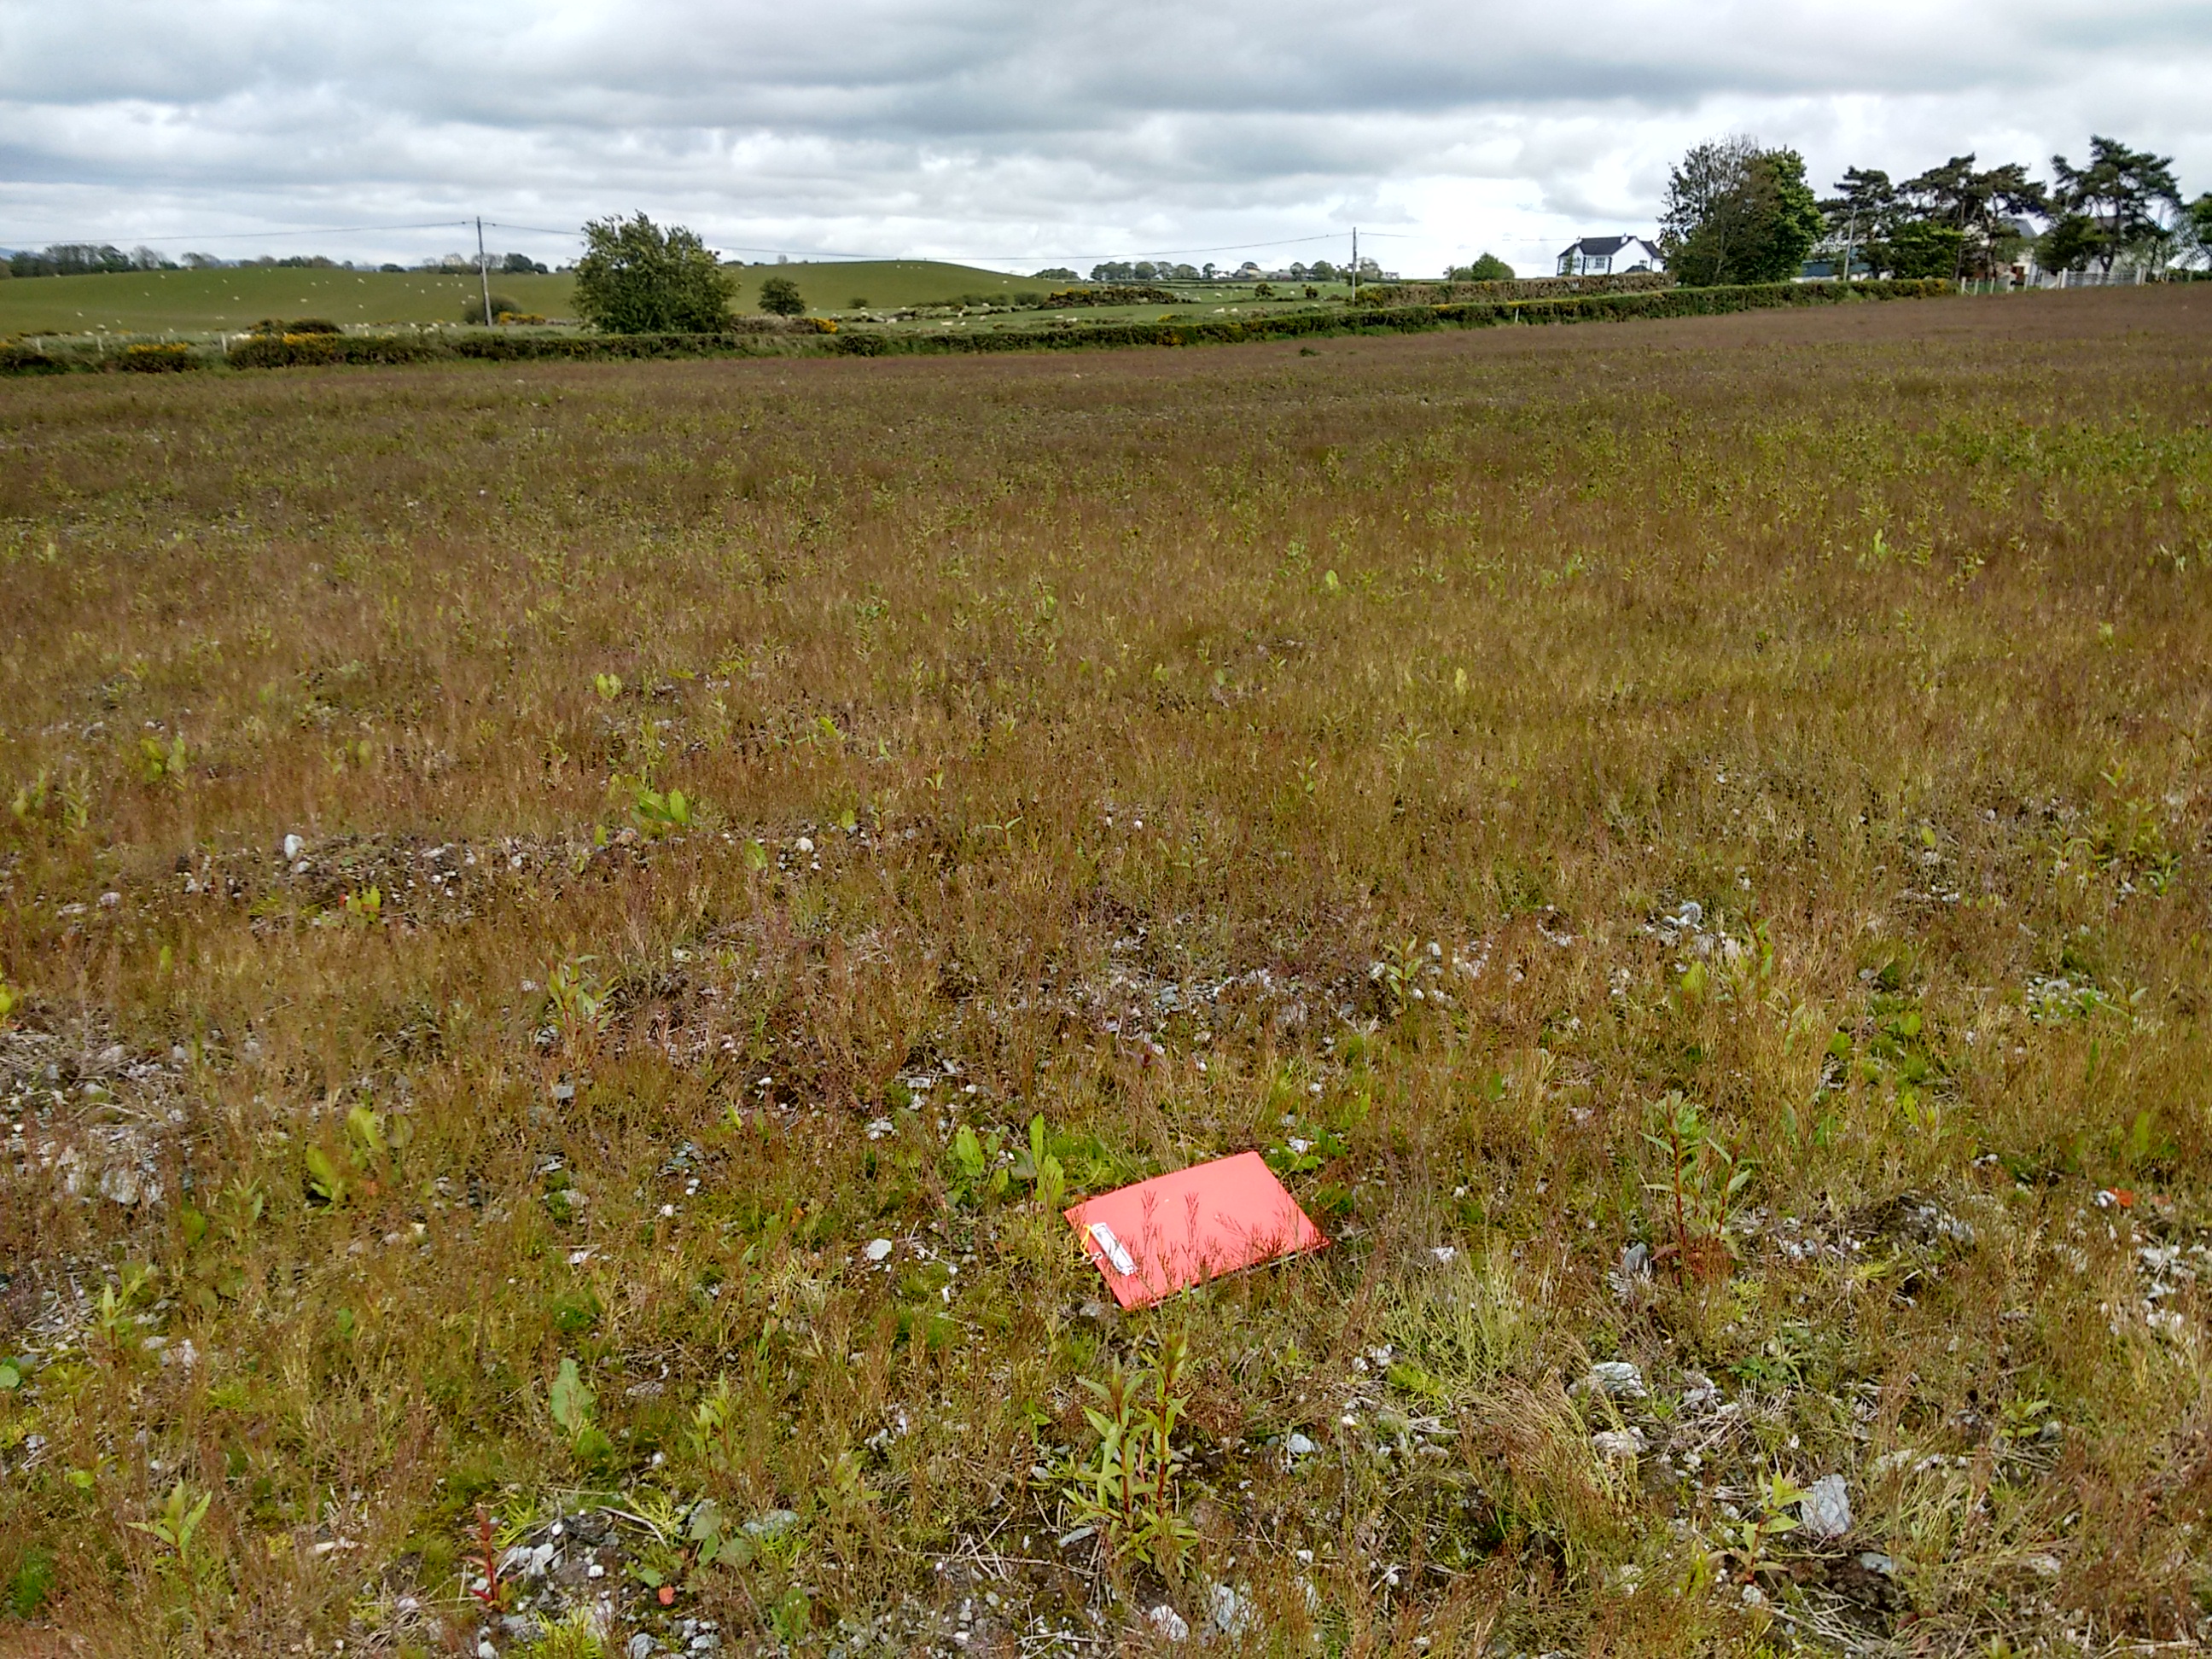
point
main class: Grassland
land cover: Spontaneously vegetated surfaces
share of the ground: > 75 %
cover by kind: herbaceous plants 100 %
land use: Agriculture (excluding fallow land and kitchen gardens)
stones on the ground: 25 - 50 %
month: June
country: GB
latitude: 55.0289
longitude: -7.0831
